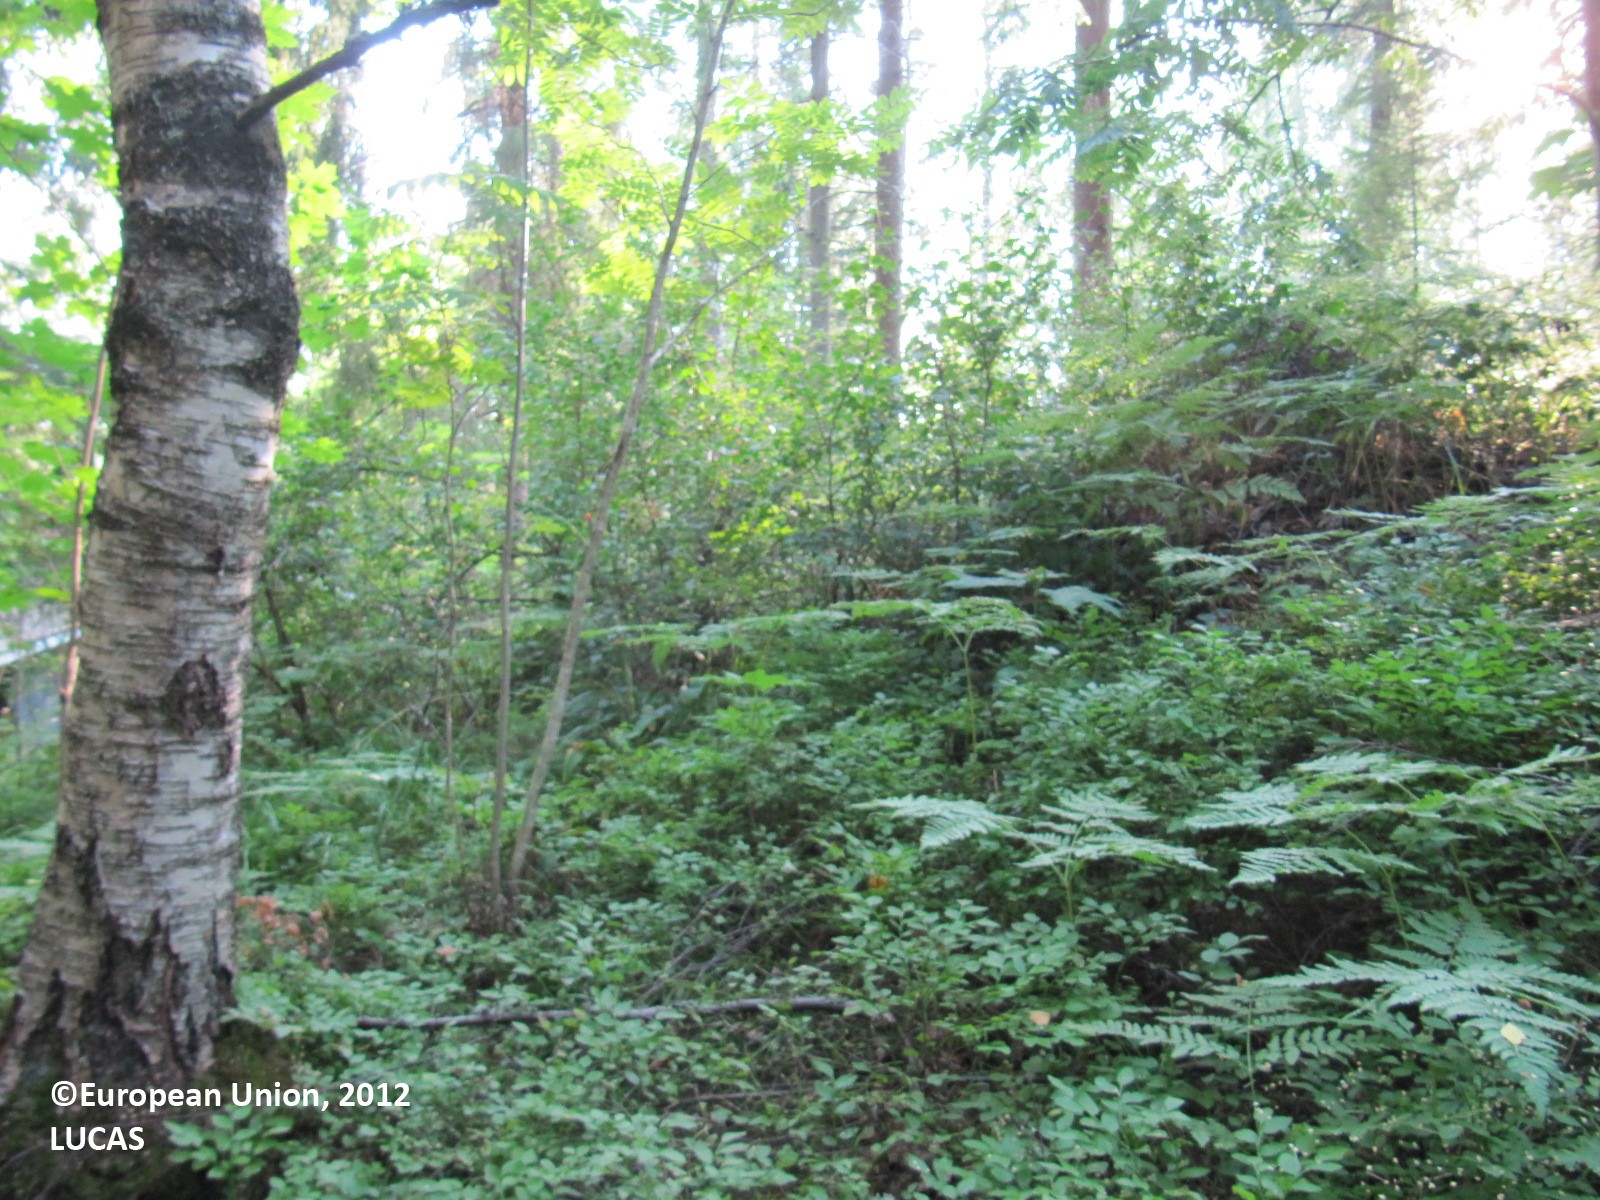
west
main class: Woodland
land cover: Spruce dominated mixed woodland
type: boreal forest
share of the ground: > 75 %
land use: Forestry
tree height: > 5 m
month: August
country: FI
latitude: 60.5426
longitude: 24.5261
